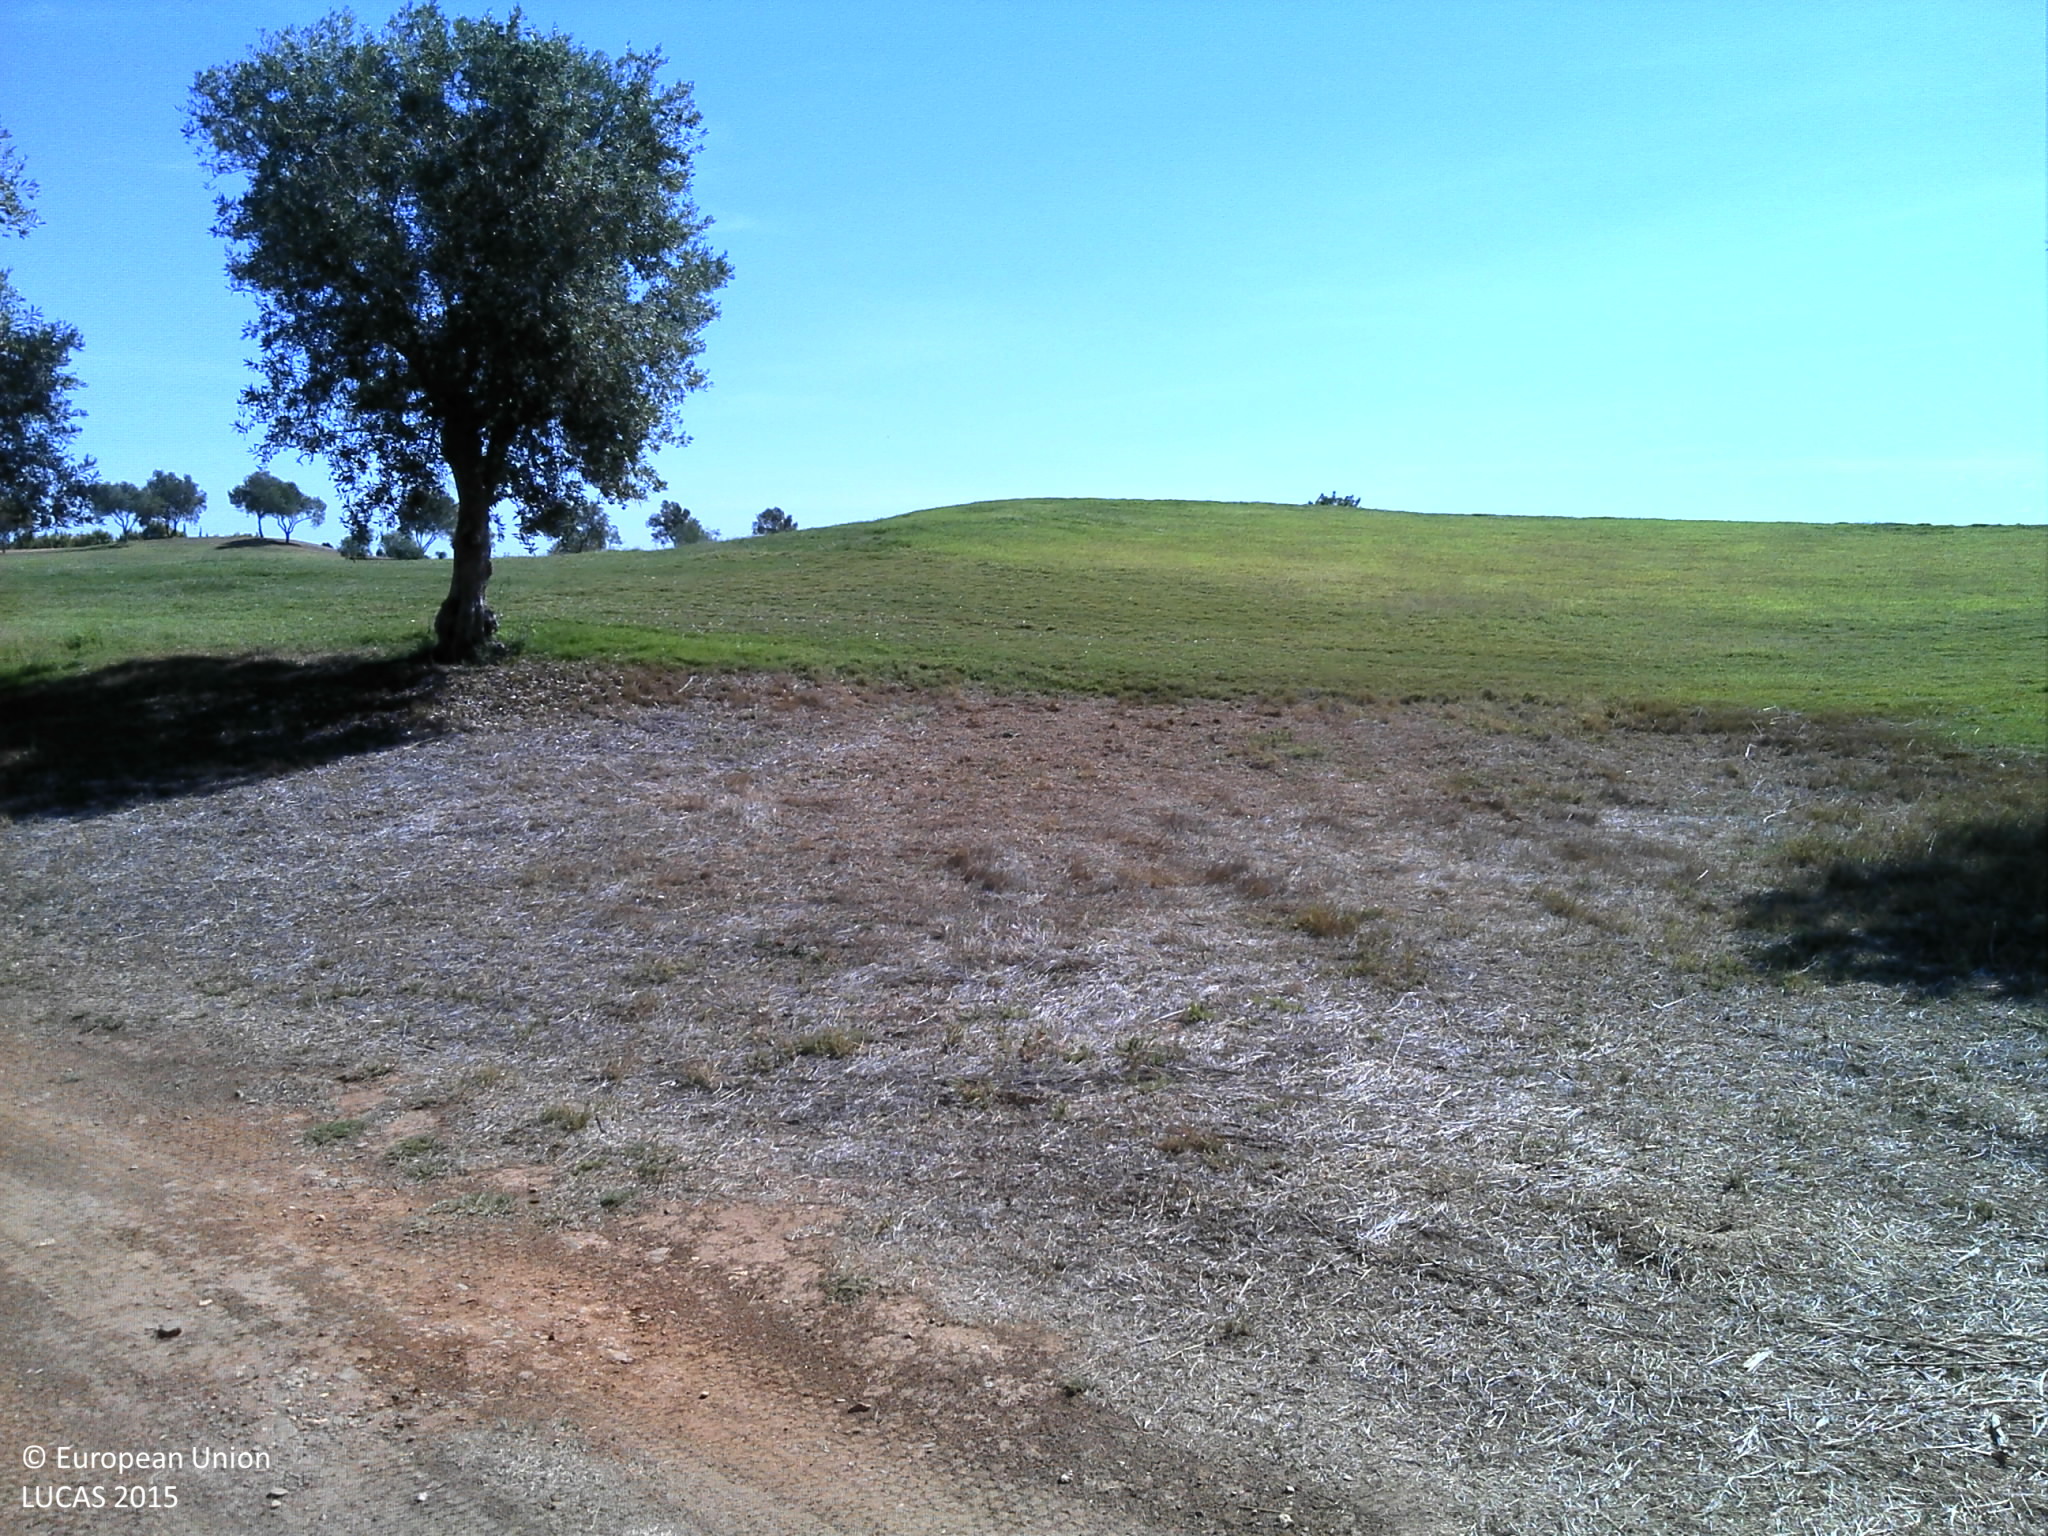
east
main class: Cropland
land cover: Olive groves
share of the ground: 25 - 50 %
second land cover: Grassland without tree/shrub cover
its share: 50 - 75 %
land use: Amenities, museums, leisure
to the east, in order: Olive groves; Grassland without tree/shrub cover; Tracks; Olive groves; Grassland without tree/shrub cover; Ponds and wetlands
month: September
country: PT
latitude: 37.0982
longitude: -8.1413
